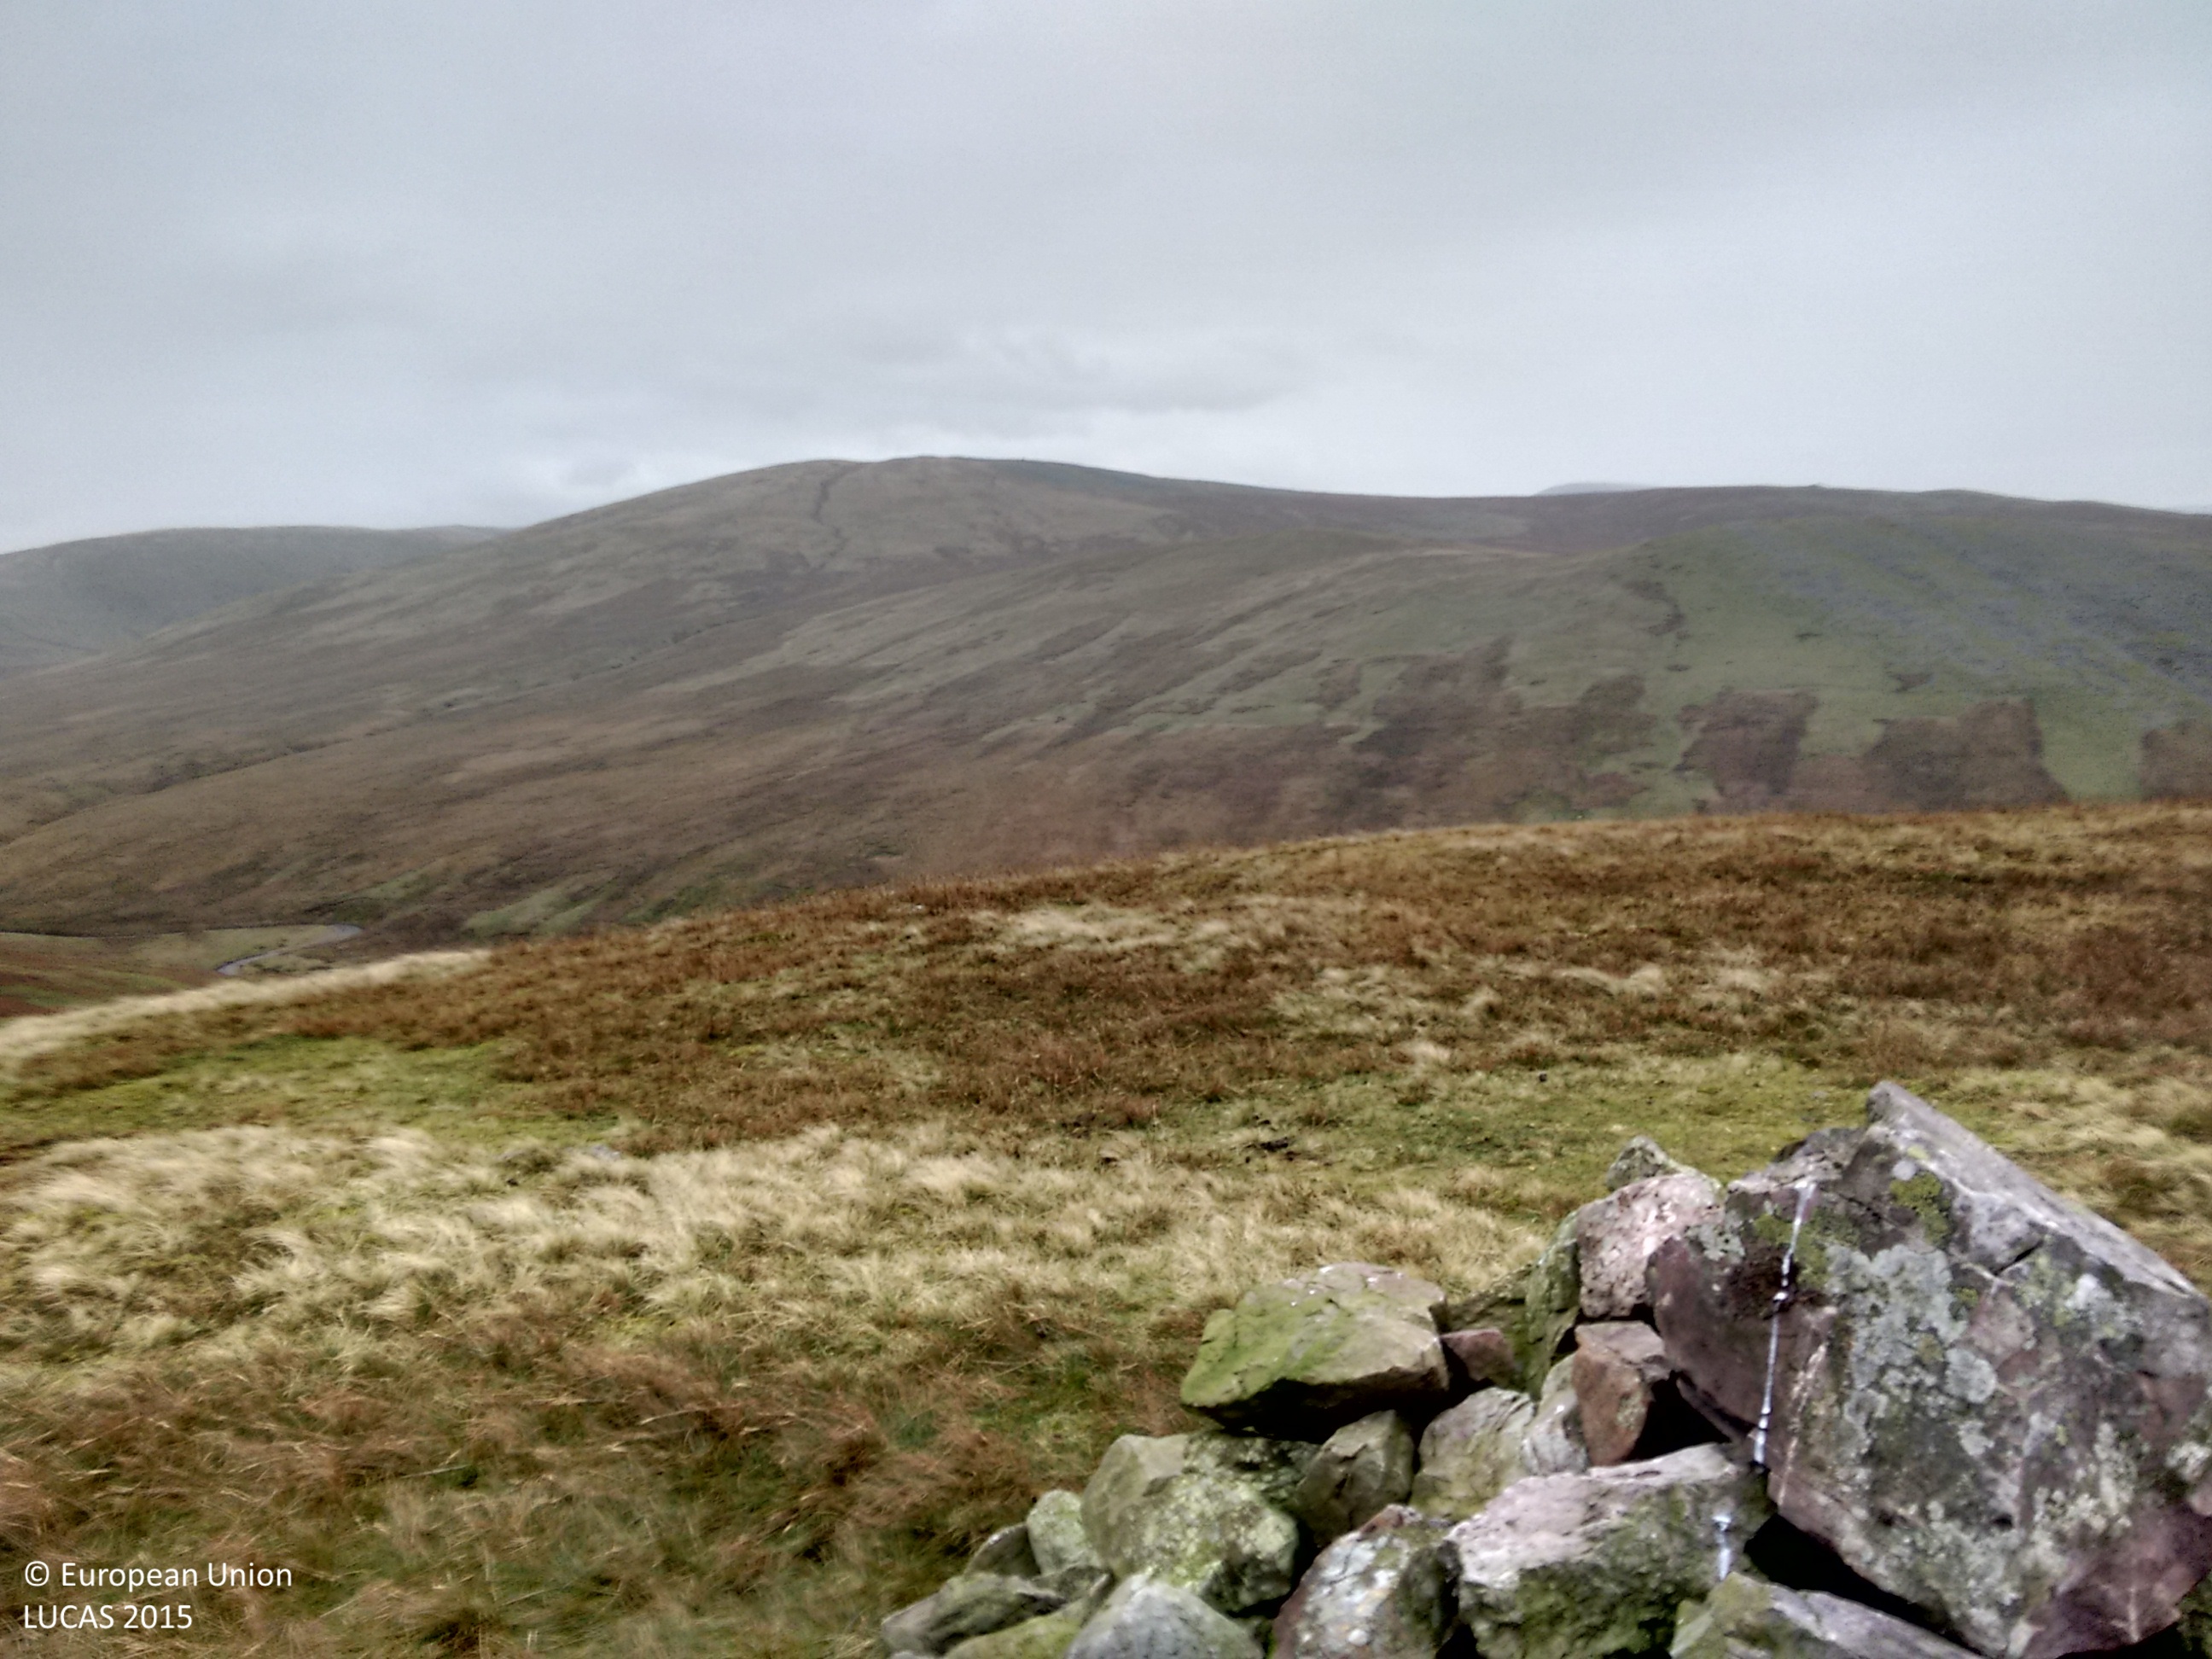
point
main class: Grassland
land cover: Grassland without tree/shrub cover
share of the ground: > 75 %
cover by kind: herbaceous plants 100 %
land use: Agriculture (excluding fallow land and kitchen gardens)
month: November
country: GB
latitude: 54.4914
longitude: -3.4346
